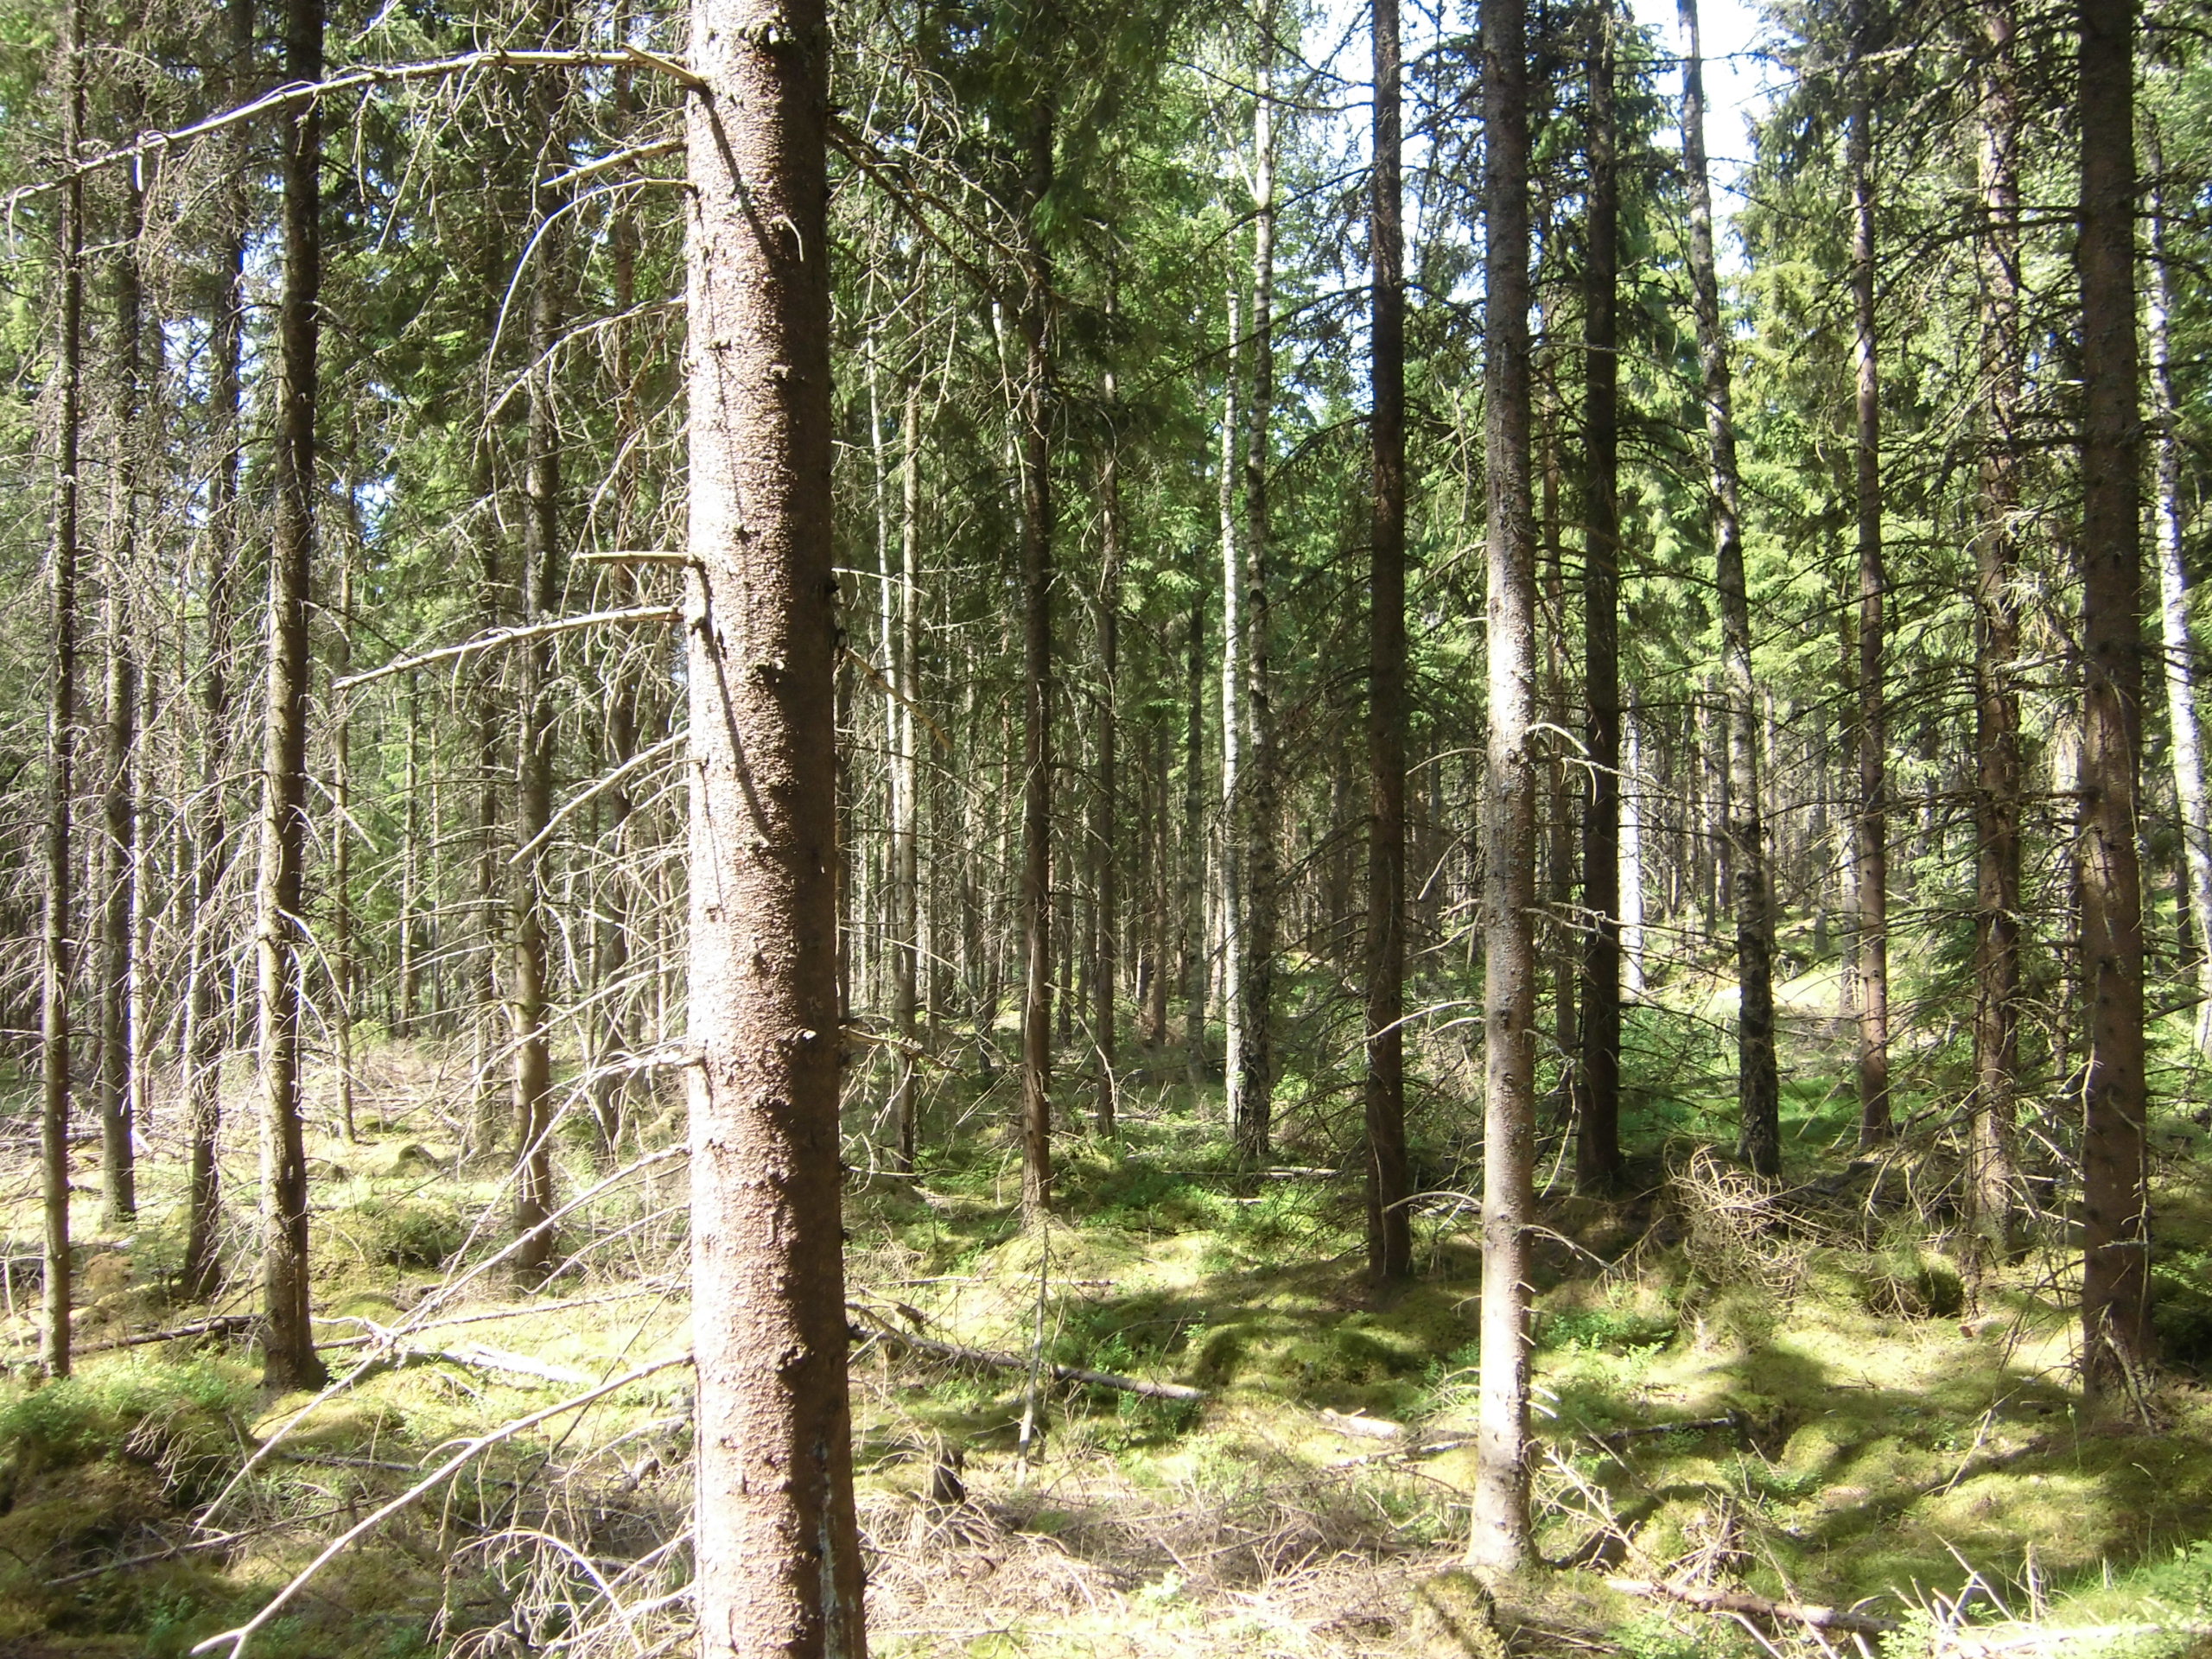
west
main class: Woodland
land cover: Spruce dominated coniferous woodland
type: boreal forest
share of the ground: 50 - 75 %
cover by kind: coniferous forest trees 55 %, shrubs 15 %, herbaceous plants 15 %, broadleaved forest trees 10 %, unconsolidated bare surface 5 %
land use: Forestry
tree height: > 5 m
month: July
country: SE
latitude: 57.2920
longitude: 14.6588
